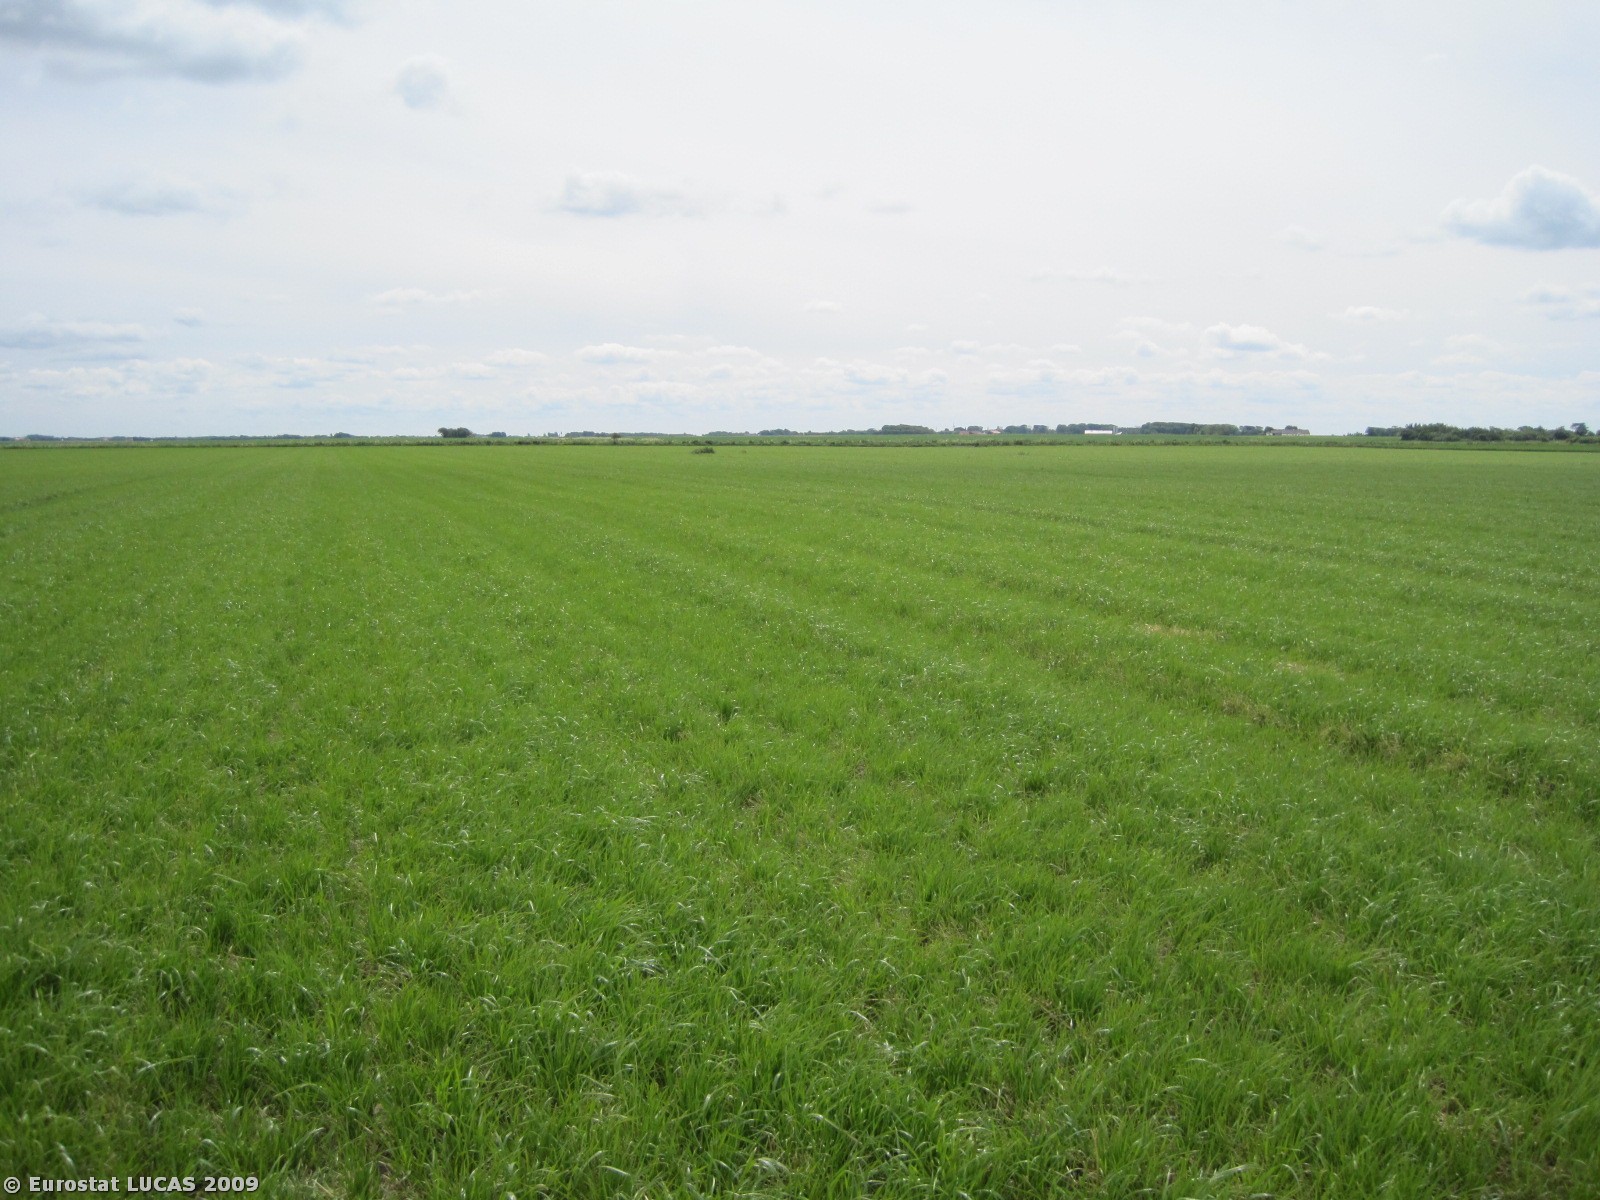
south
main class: Cropland
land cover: Temporary grasslands
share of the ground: > 75 %
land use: Agriculture (excluding fallow land and kitchen gardens)
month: June
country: DK
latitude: 57.3201
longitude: 9.7513
